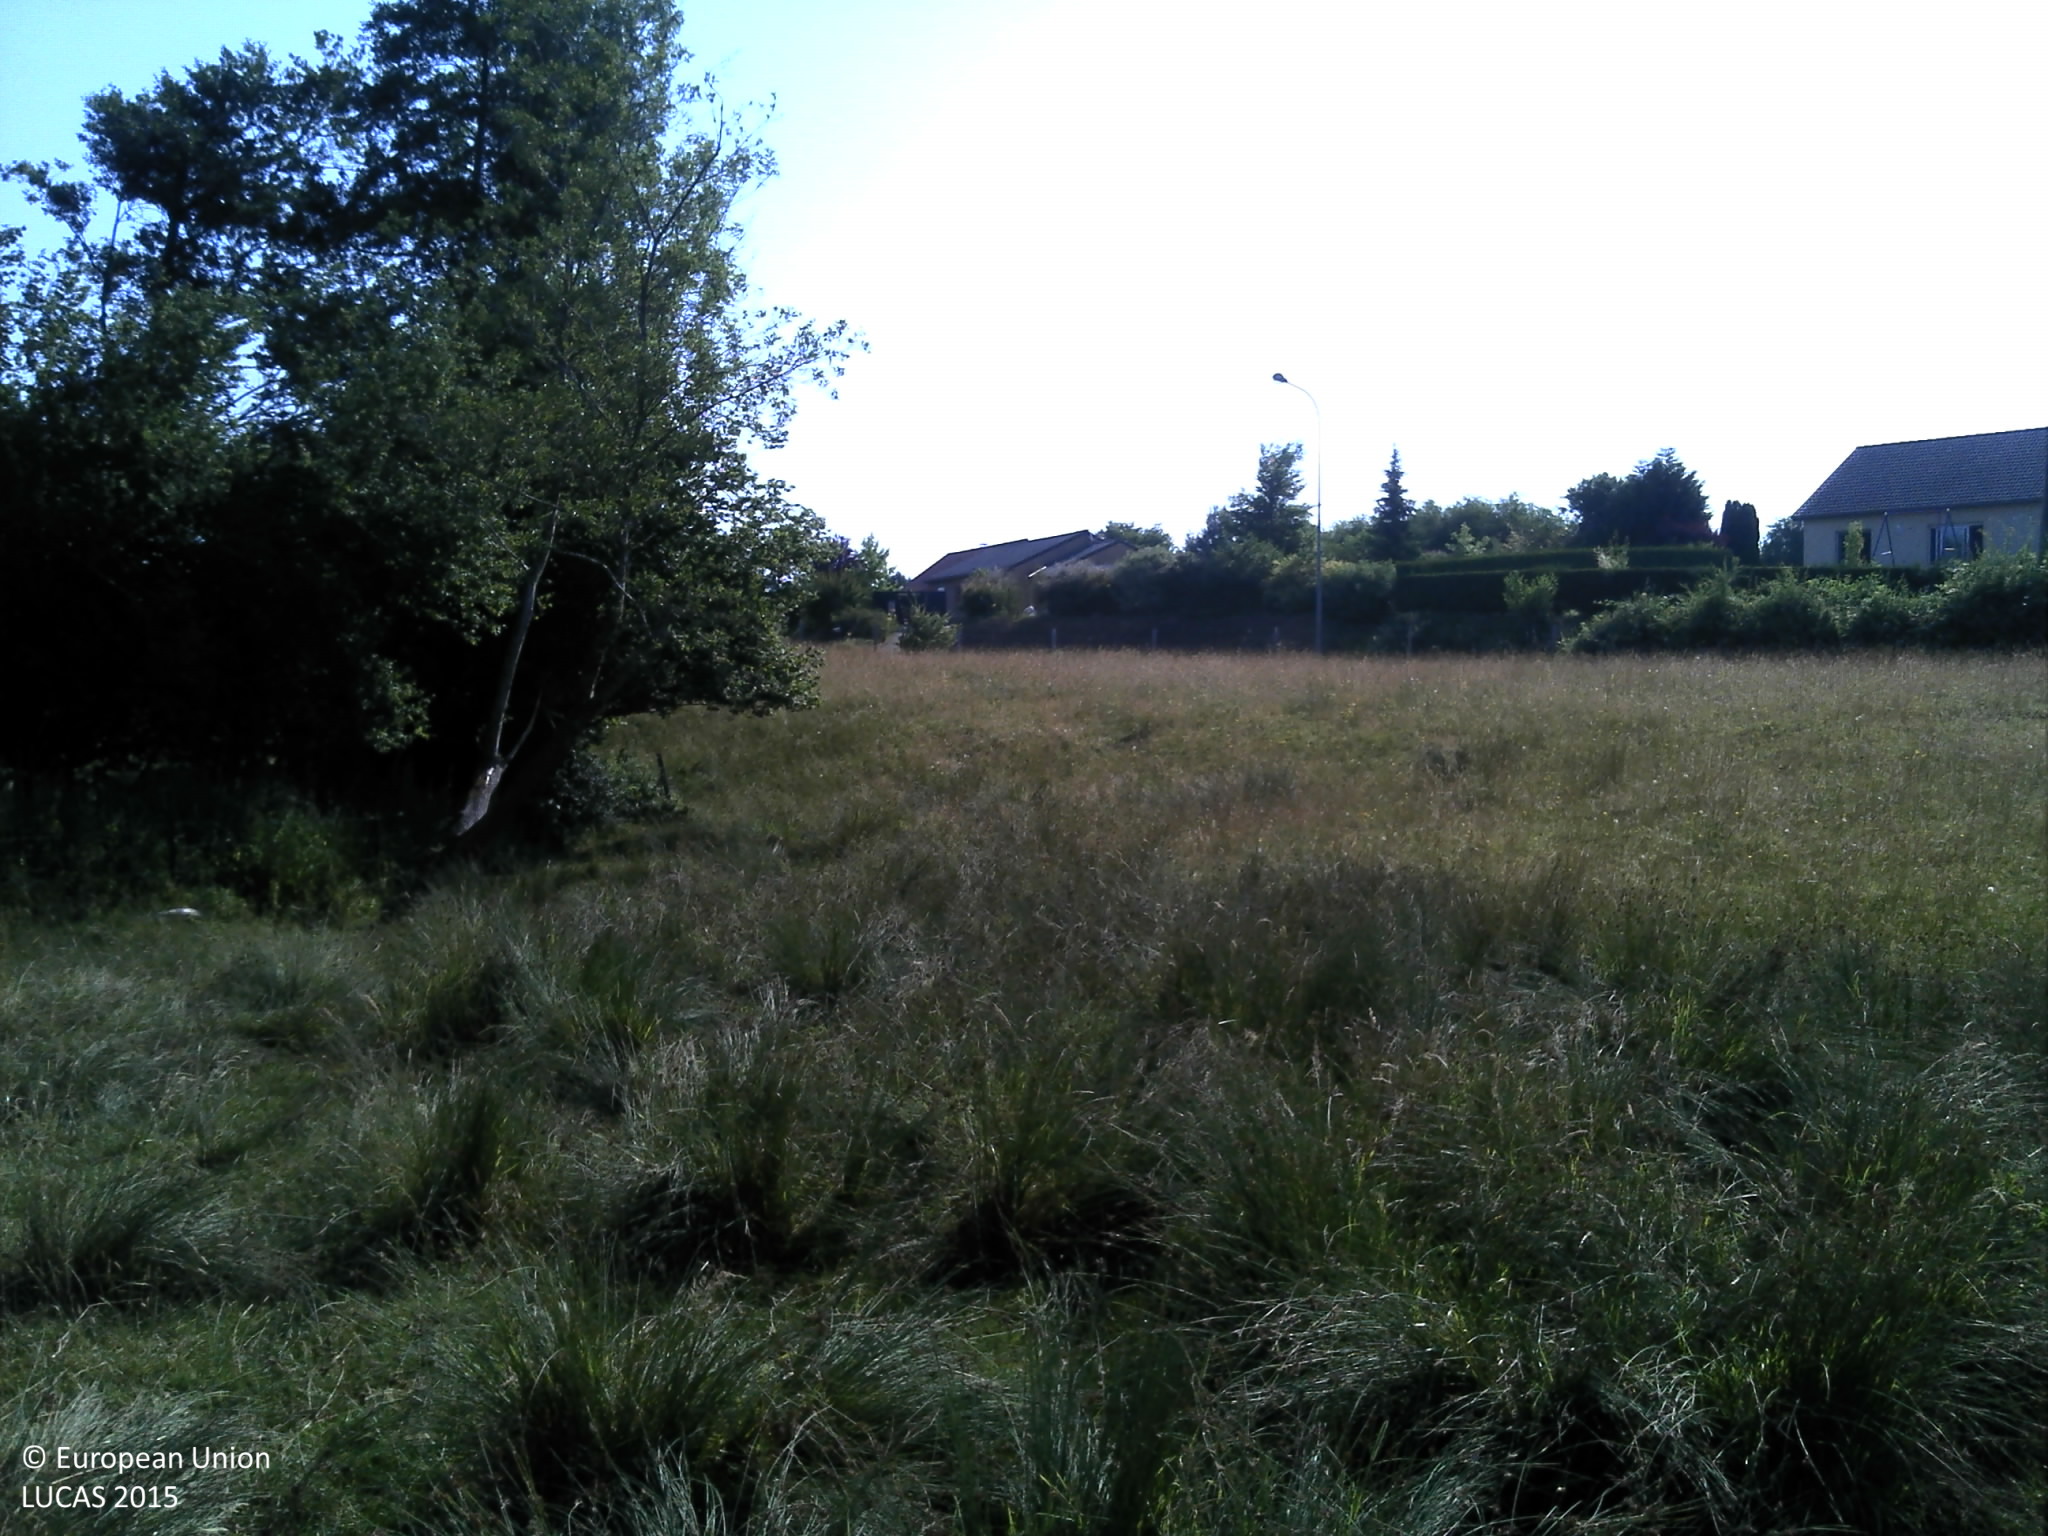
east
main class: Grassland
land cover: Grassland without tree/shrub cover
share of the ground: > 75 %
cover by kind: herbaceous plants 100 %
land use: Agriculture (excluding fallow land and kitchen gardens)
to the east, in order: Grassland without tree/shrub cover; Fences; Broadleaved woodland; Inland fresh running water; Broadleaved woodland; Fences; Grassland without tree/shrub cover; Fences; Electric lines; Grass margins; Paved roads, cycling and walking lanes; Grassland without tree/shrub cover; Fences; Grassland without tree/shrub cover; Abandoned hedges; Fences; Grassland without tree/shrub cover; Fences; Artificial constructions in urban areas
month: July
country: FR
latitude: 49.8341
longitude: 4.4764
